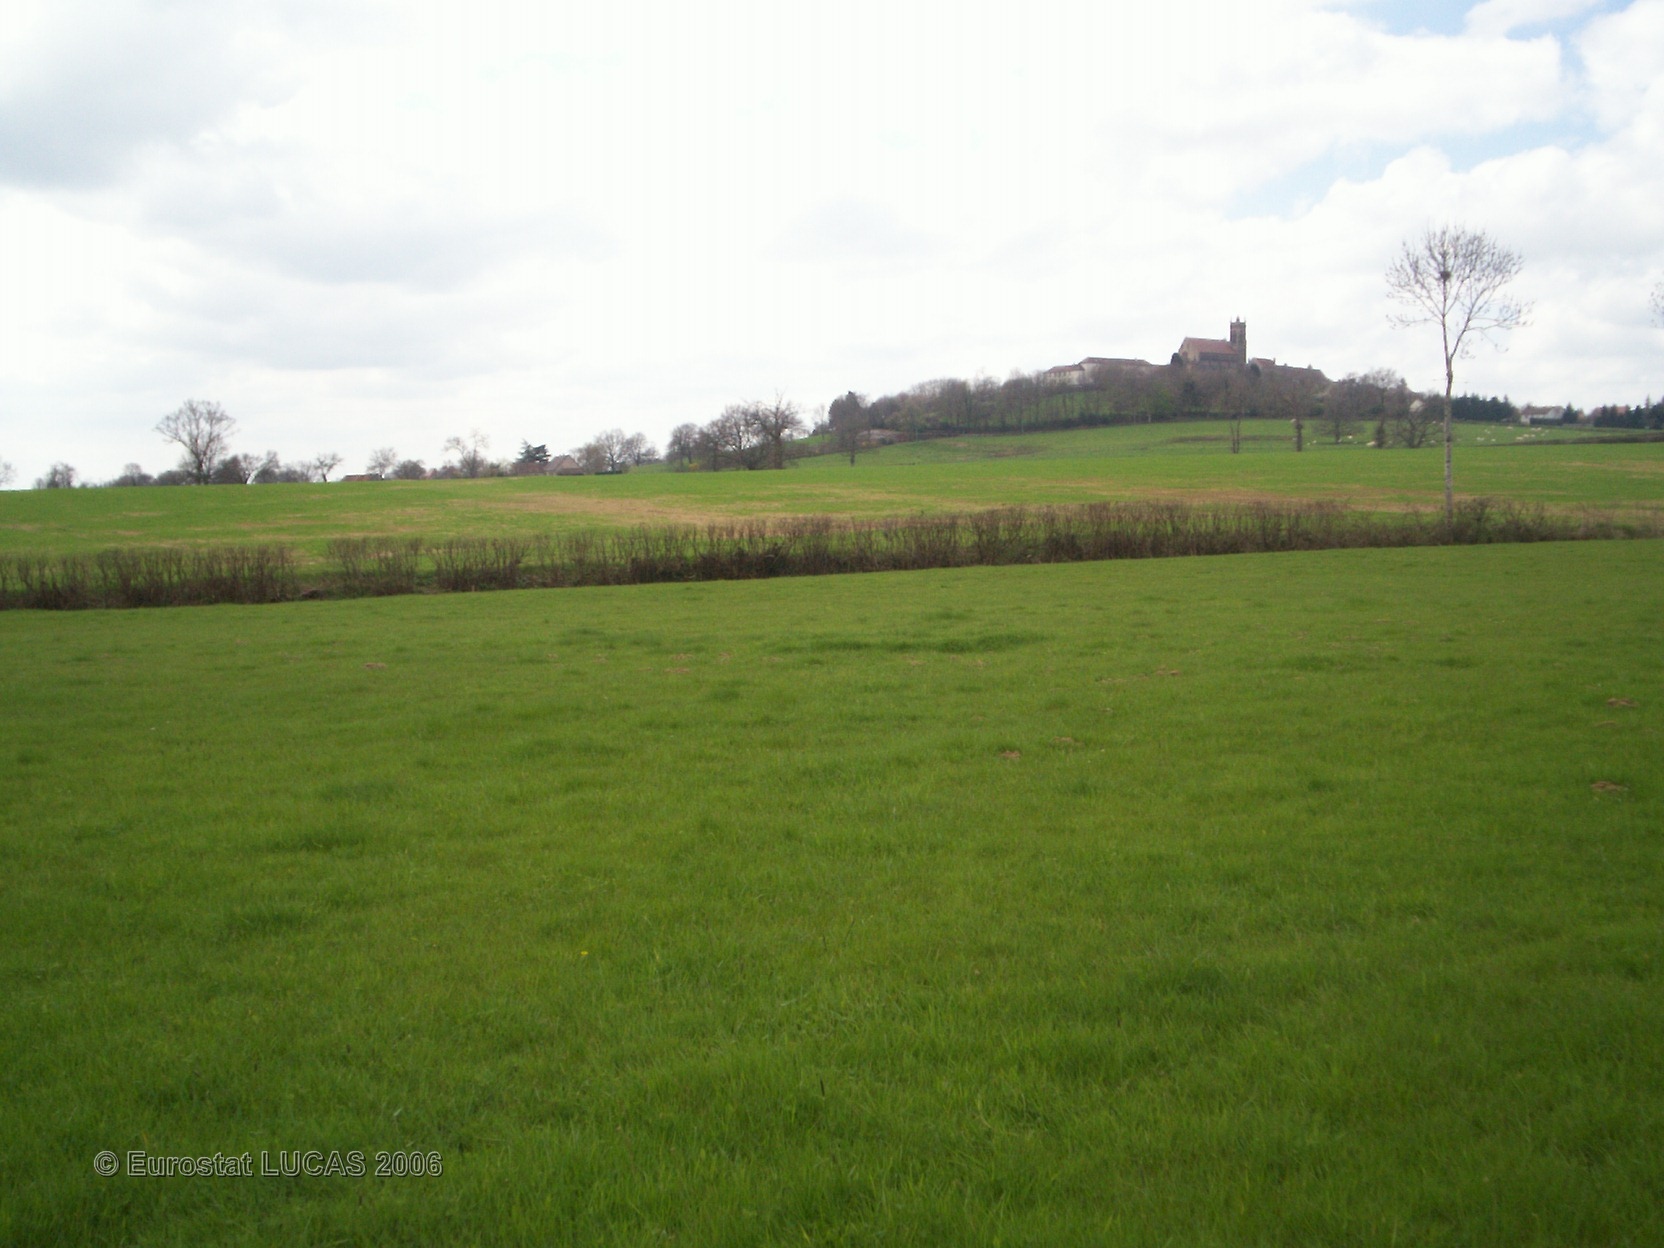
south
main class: Grassland
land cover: Grassland without tree/shrub cover
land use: Agriculture (excluding fallow land and kitchen gardens)
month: April
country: FR
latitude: 46.4151
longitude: 3.0633
